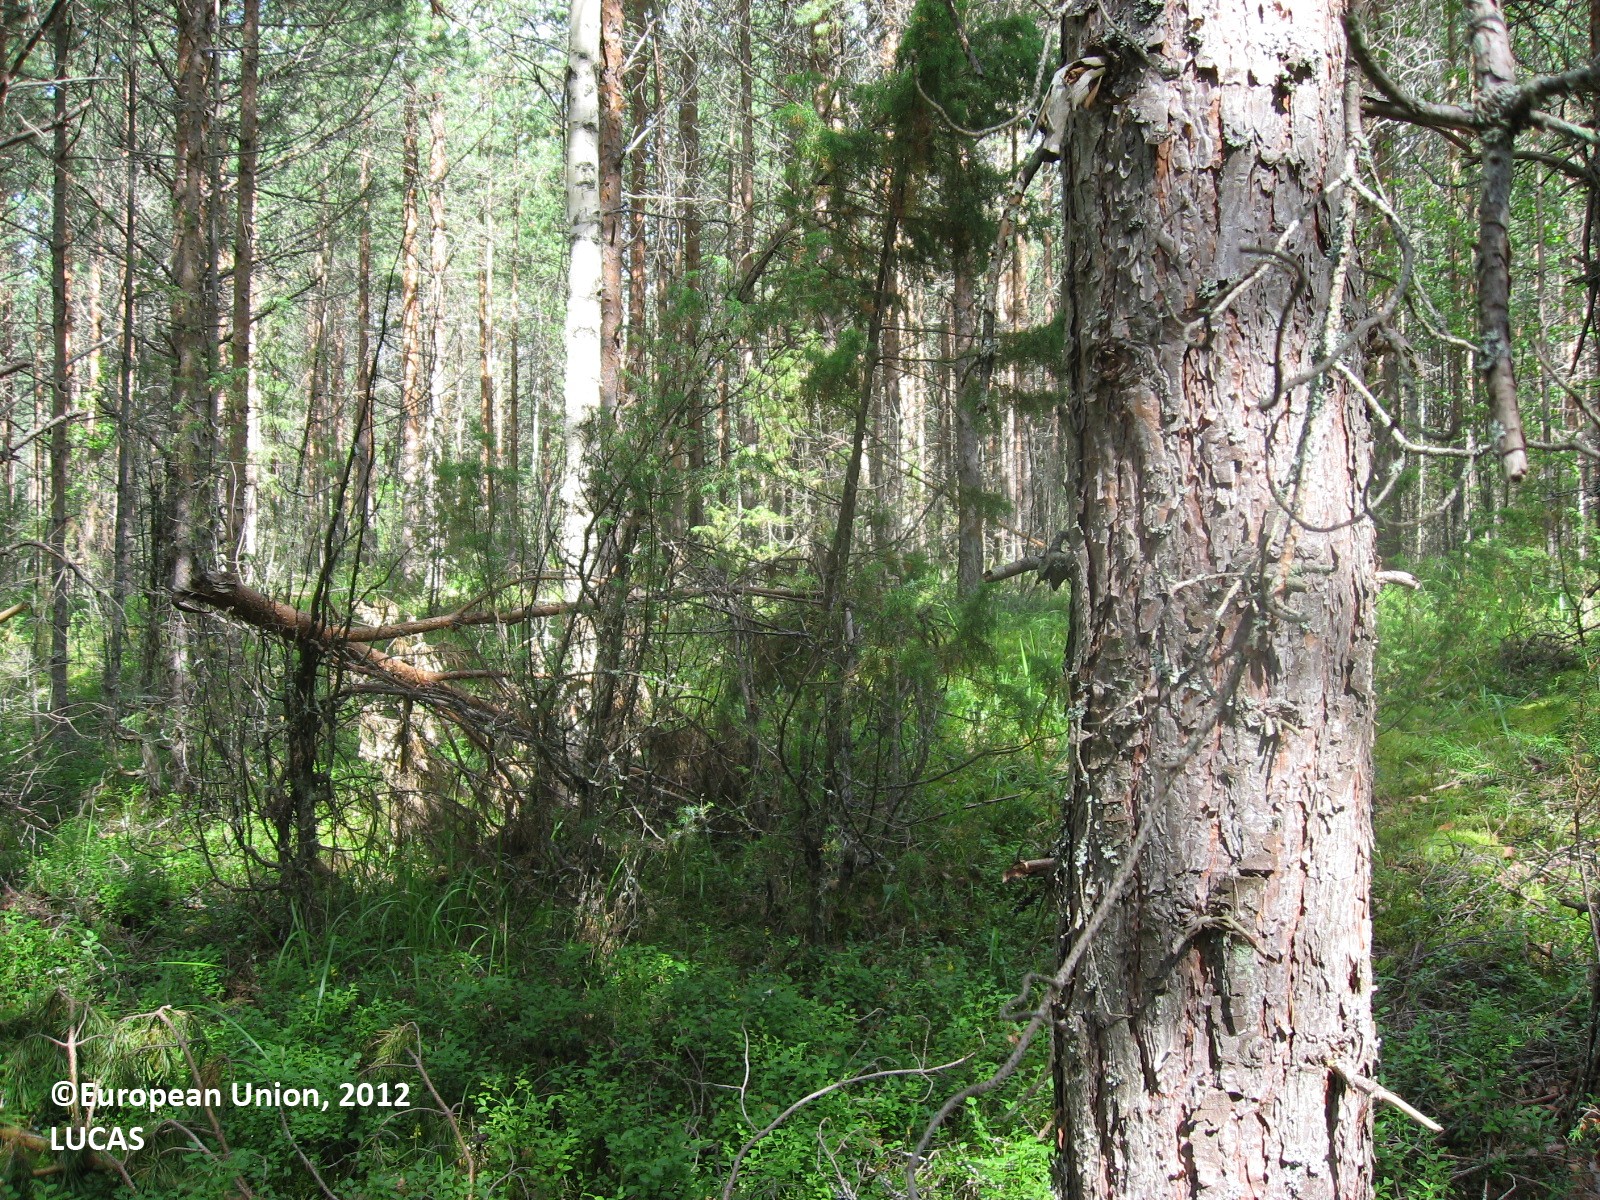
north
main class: Woodland
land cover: Pine dominated coniferous woodland
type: boreal forest
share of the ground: > 75 %
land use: Forestry
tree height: > 5 m
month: July
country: FI
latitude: 61.1223
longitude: 25.8174
